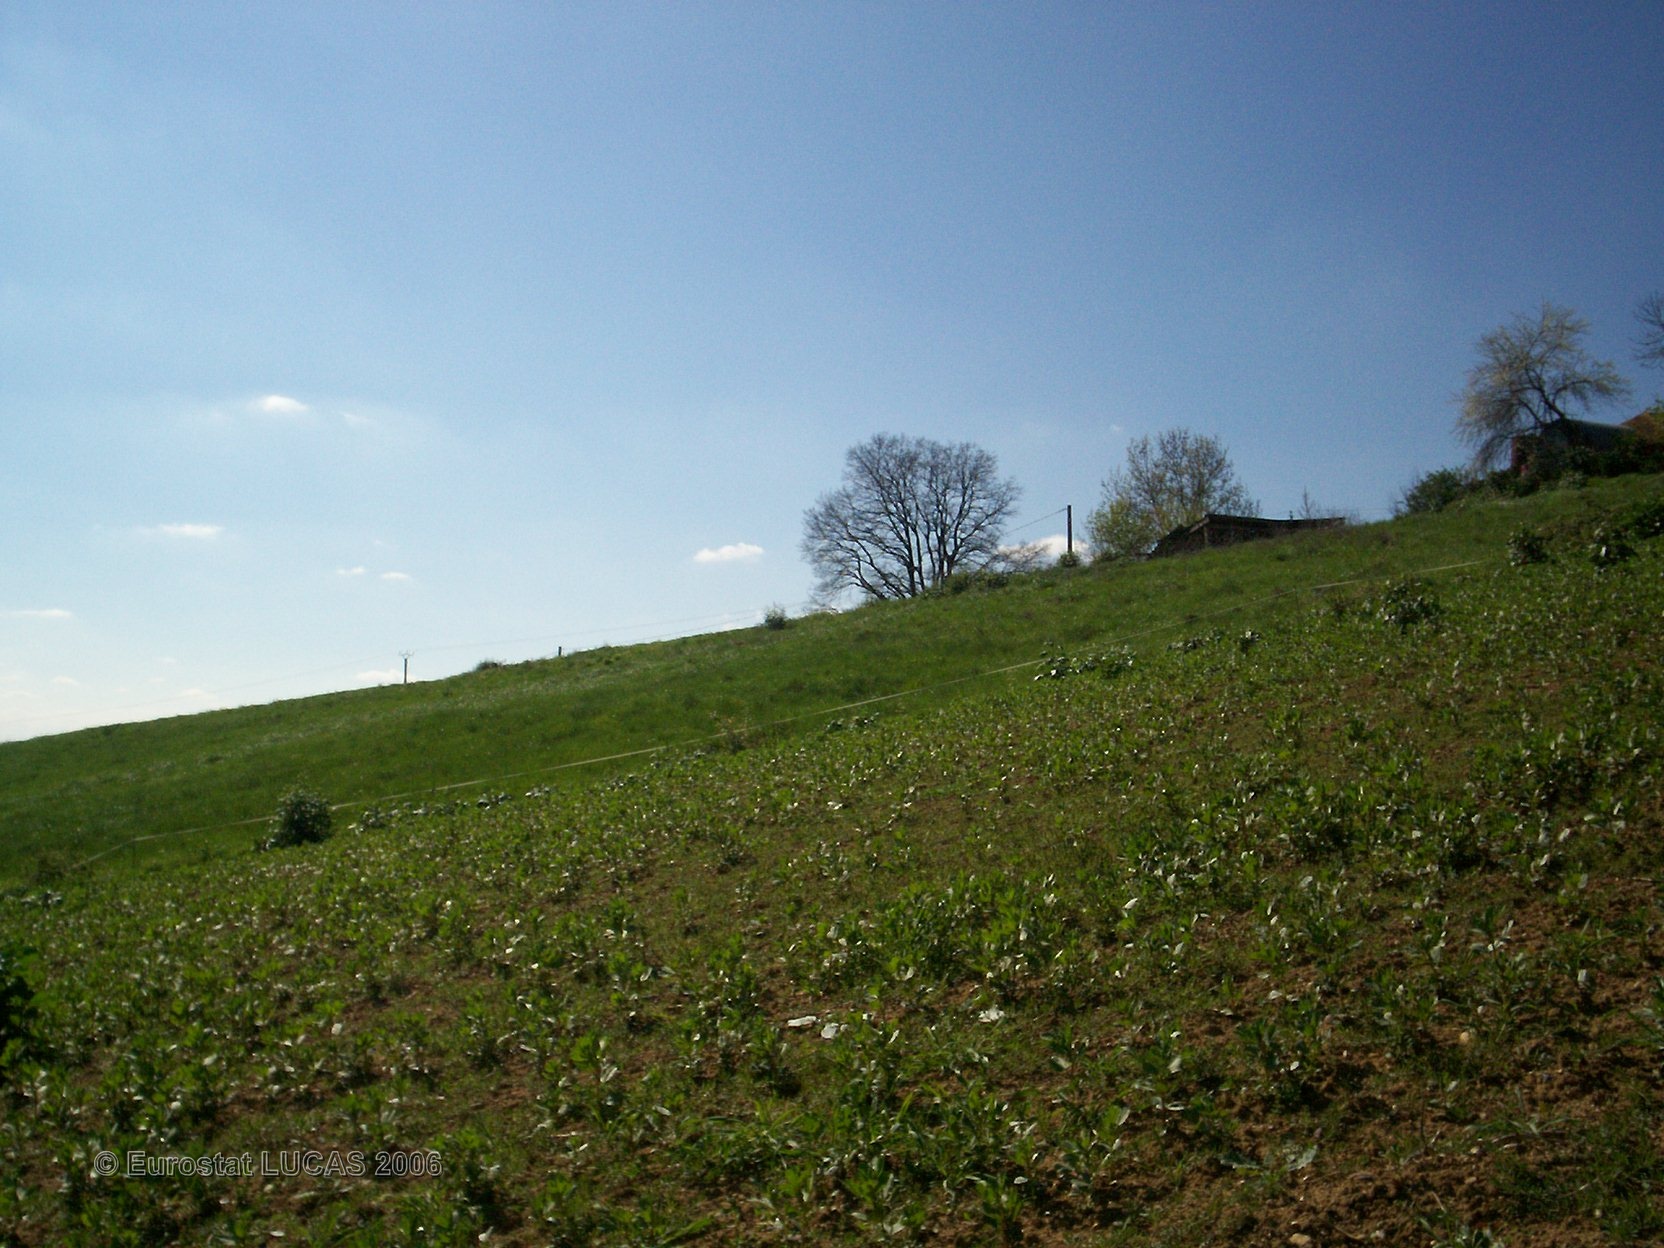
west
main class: Cropland
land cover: Dry pulses
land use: Agriculture (excluding fallow land and kitchen gardens)
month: April
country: FR
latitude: 43.5436
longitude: 0.2311
